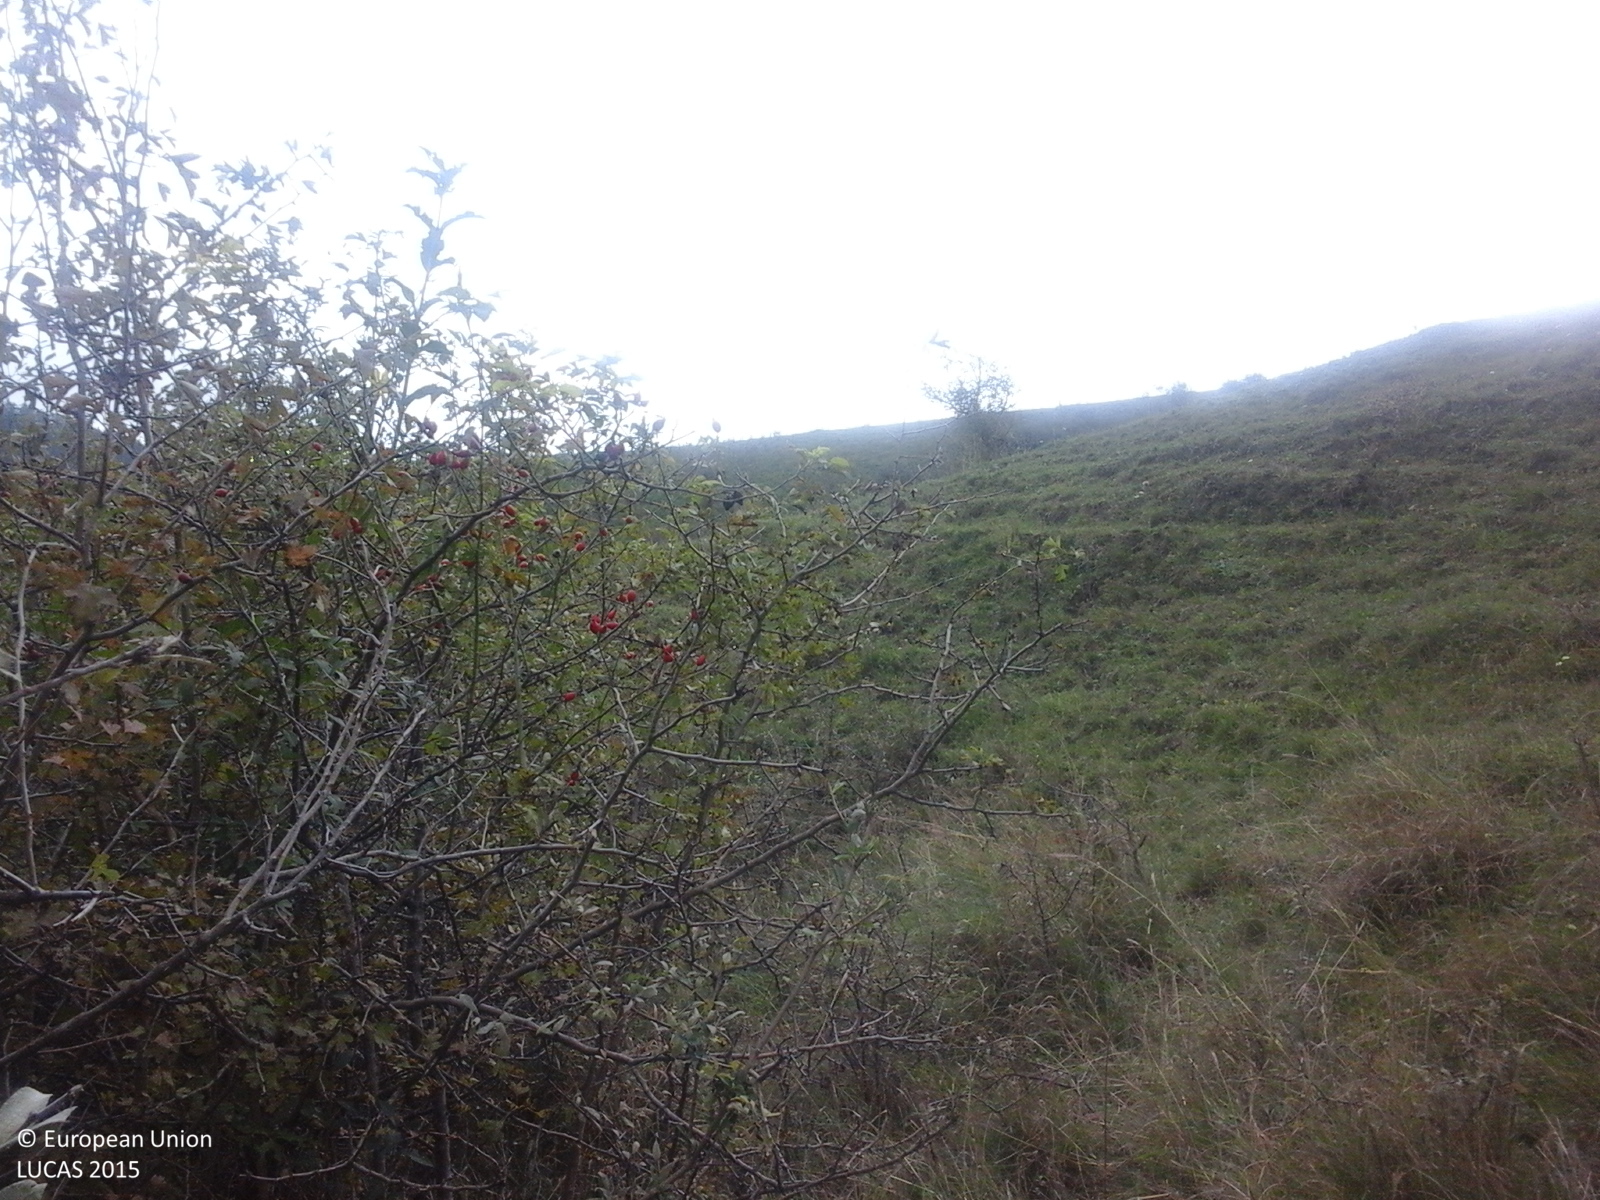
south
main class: Shrubland
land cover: Shrubland without tree cover
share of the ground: > 75 %
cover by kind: shrubs 100 %
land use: Semi-natural and natural areas not in use
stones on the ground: < 10 %
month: October
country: RO
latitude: 46.4422
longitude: 24.0440
